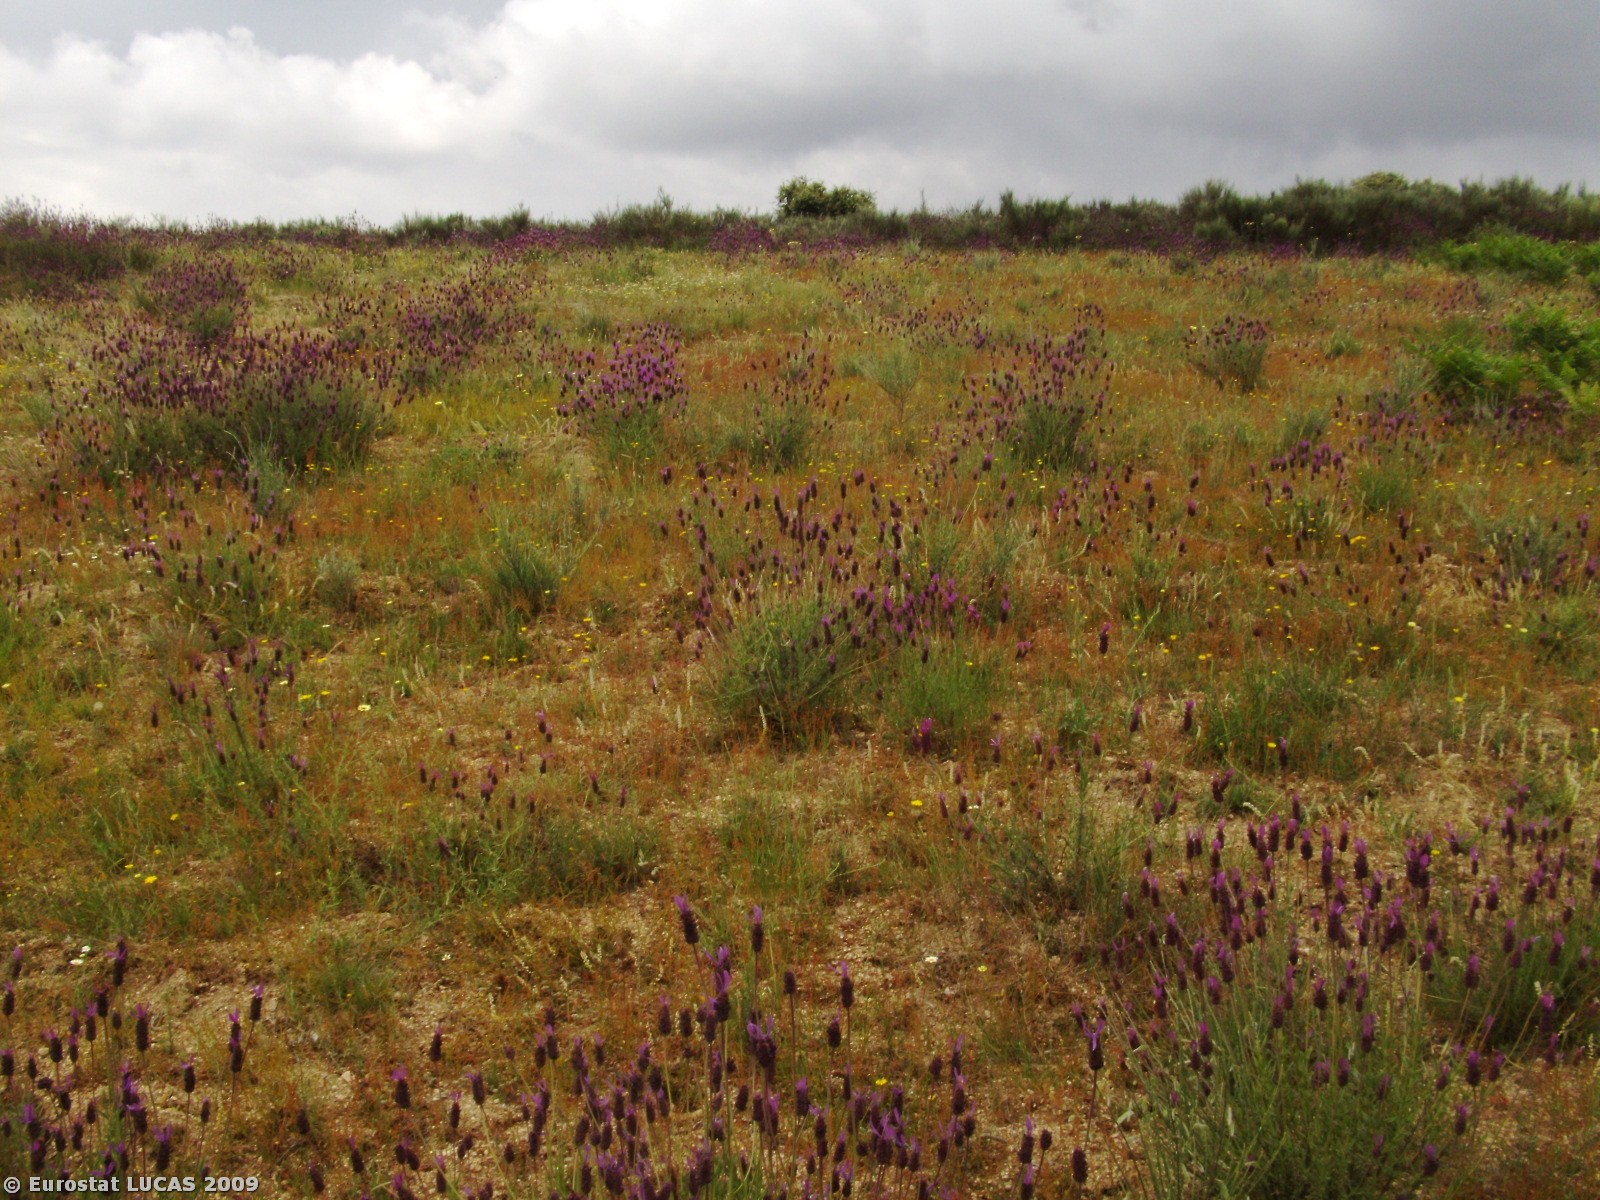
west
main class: Grassland
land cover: Spontaneously vegetated surfaces
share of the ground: > 75 %
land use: Fallow land
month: May
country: PT
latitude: 40.6947
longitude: -7.2799
